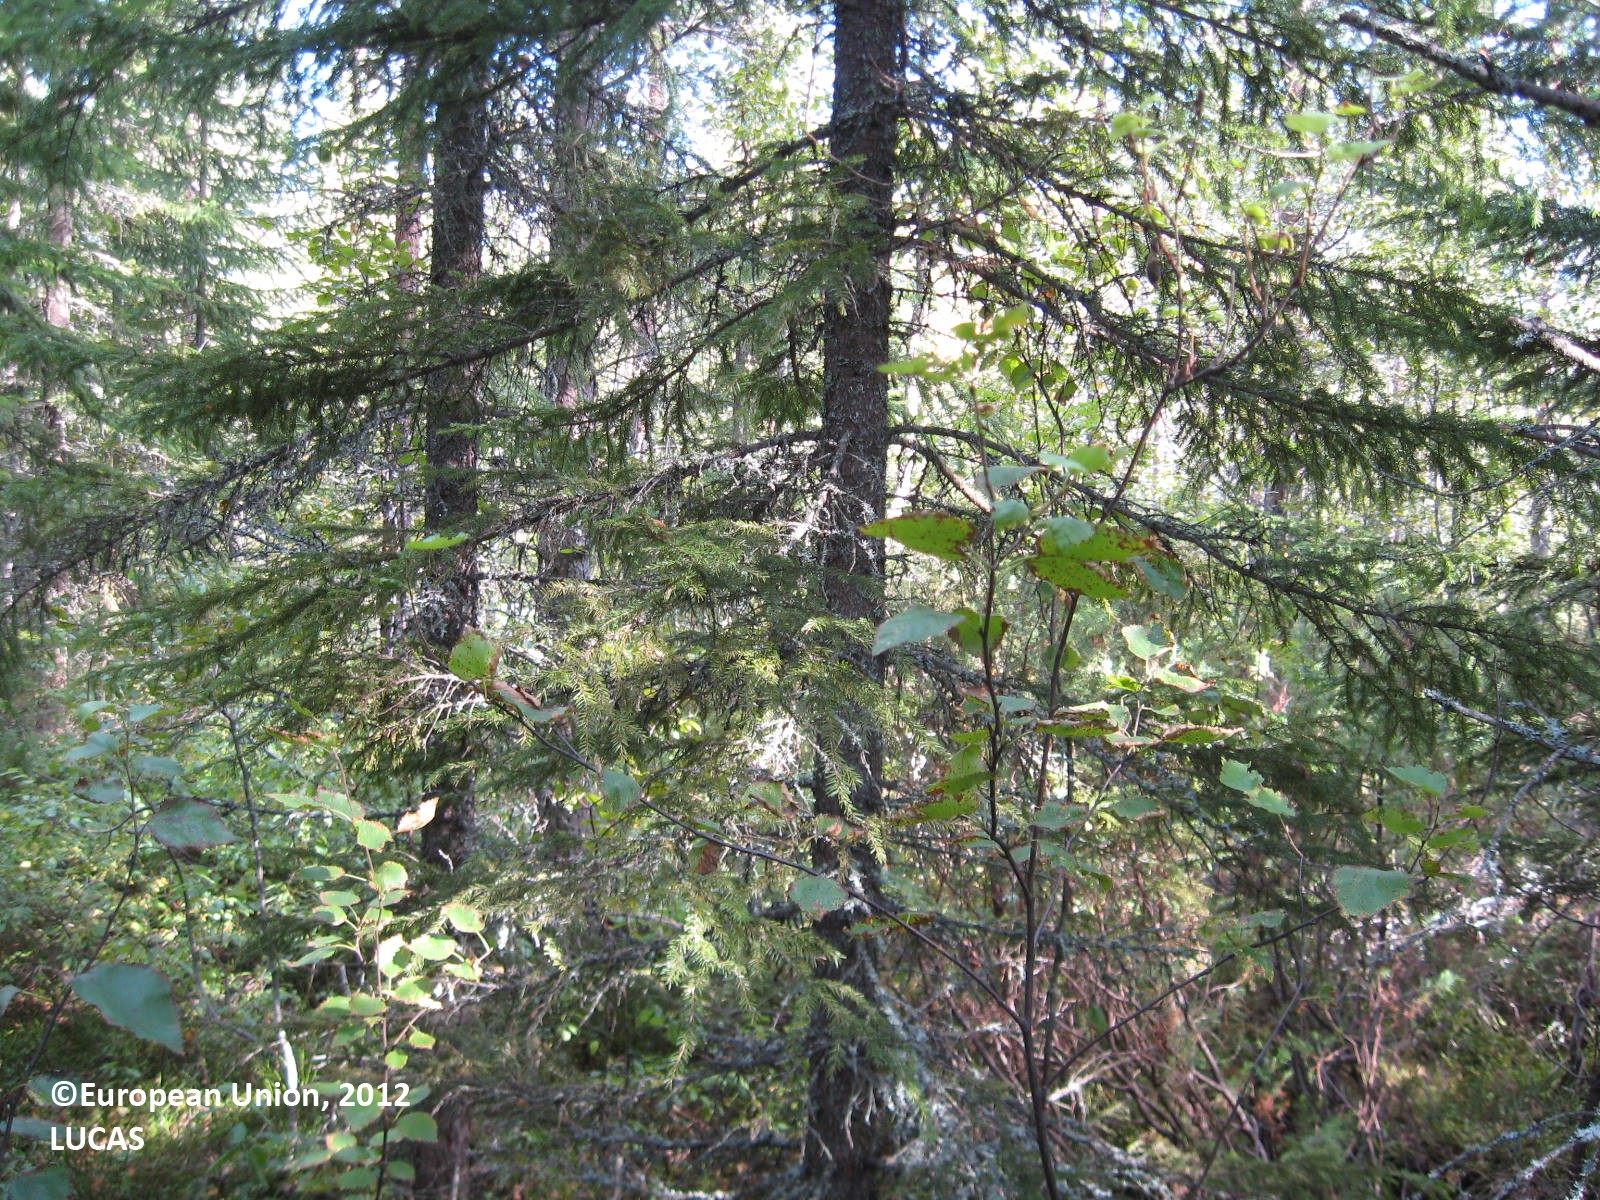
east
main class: Woodland
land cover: Other mixed woodland
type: boreal forest
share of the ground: > 75 %
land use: Forestry
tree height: > 5 m
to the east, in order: Other mixed woodland; Ditches and canals; Other coniferous woodland; Ditches and canals; Other mixed woodland; Other coniferous woodland
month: August
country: FI
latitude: 63.6898
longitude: 29.6647
